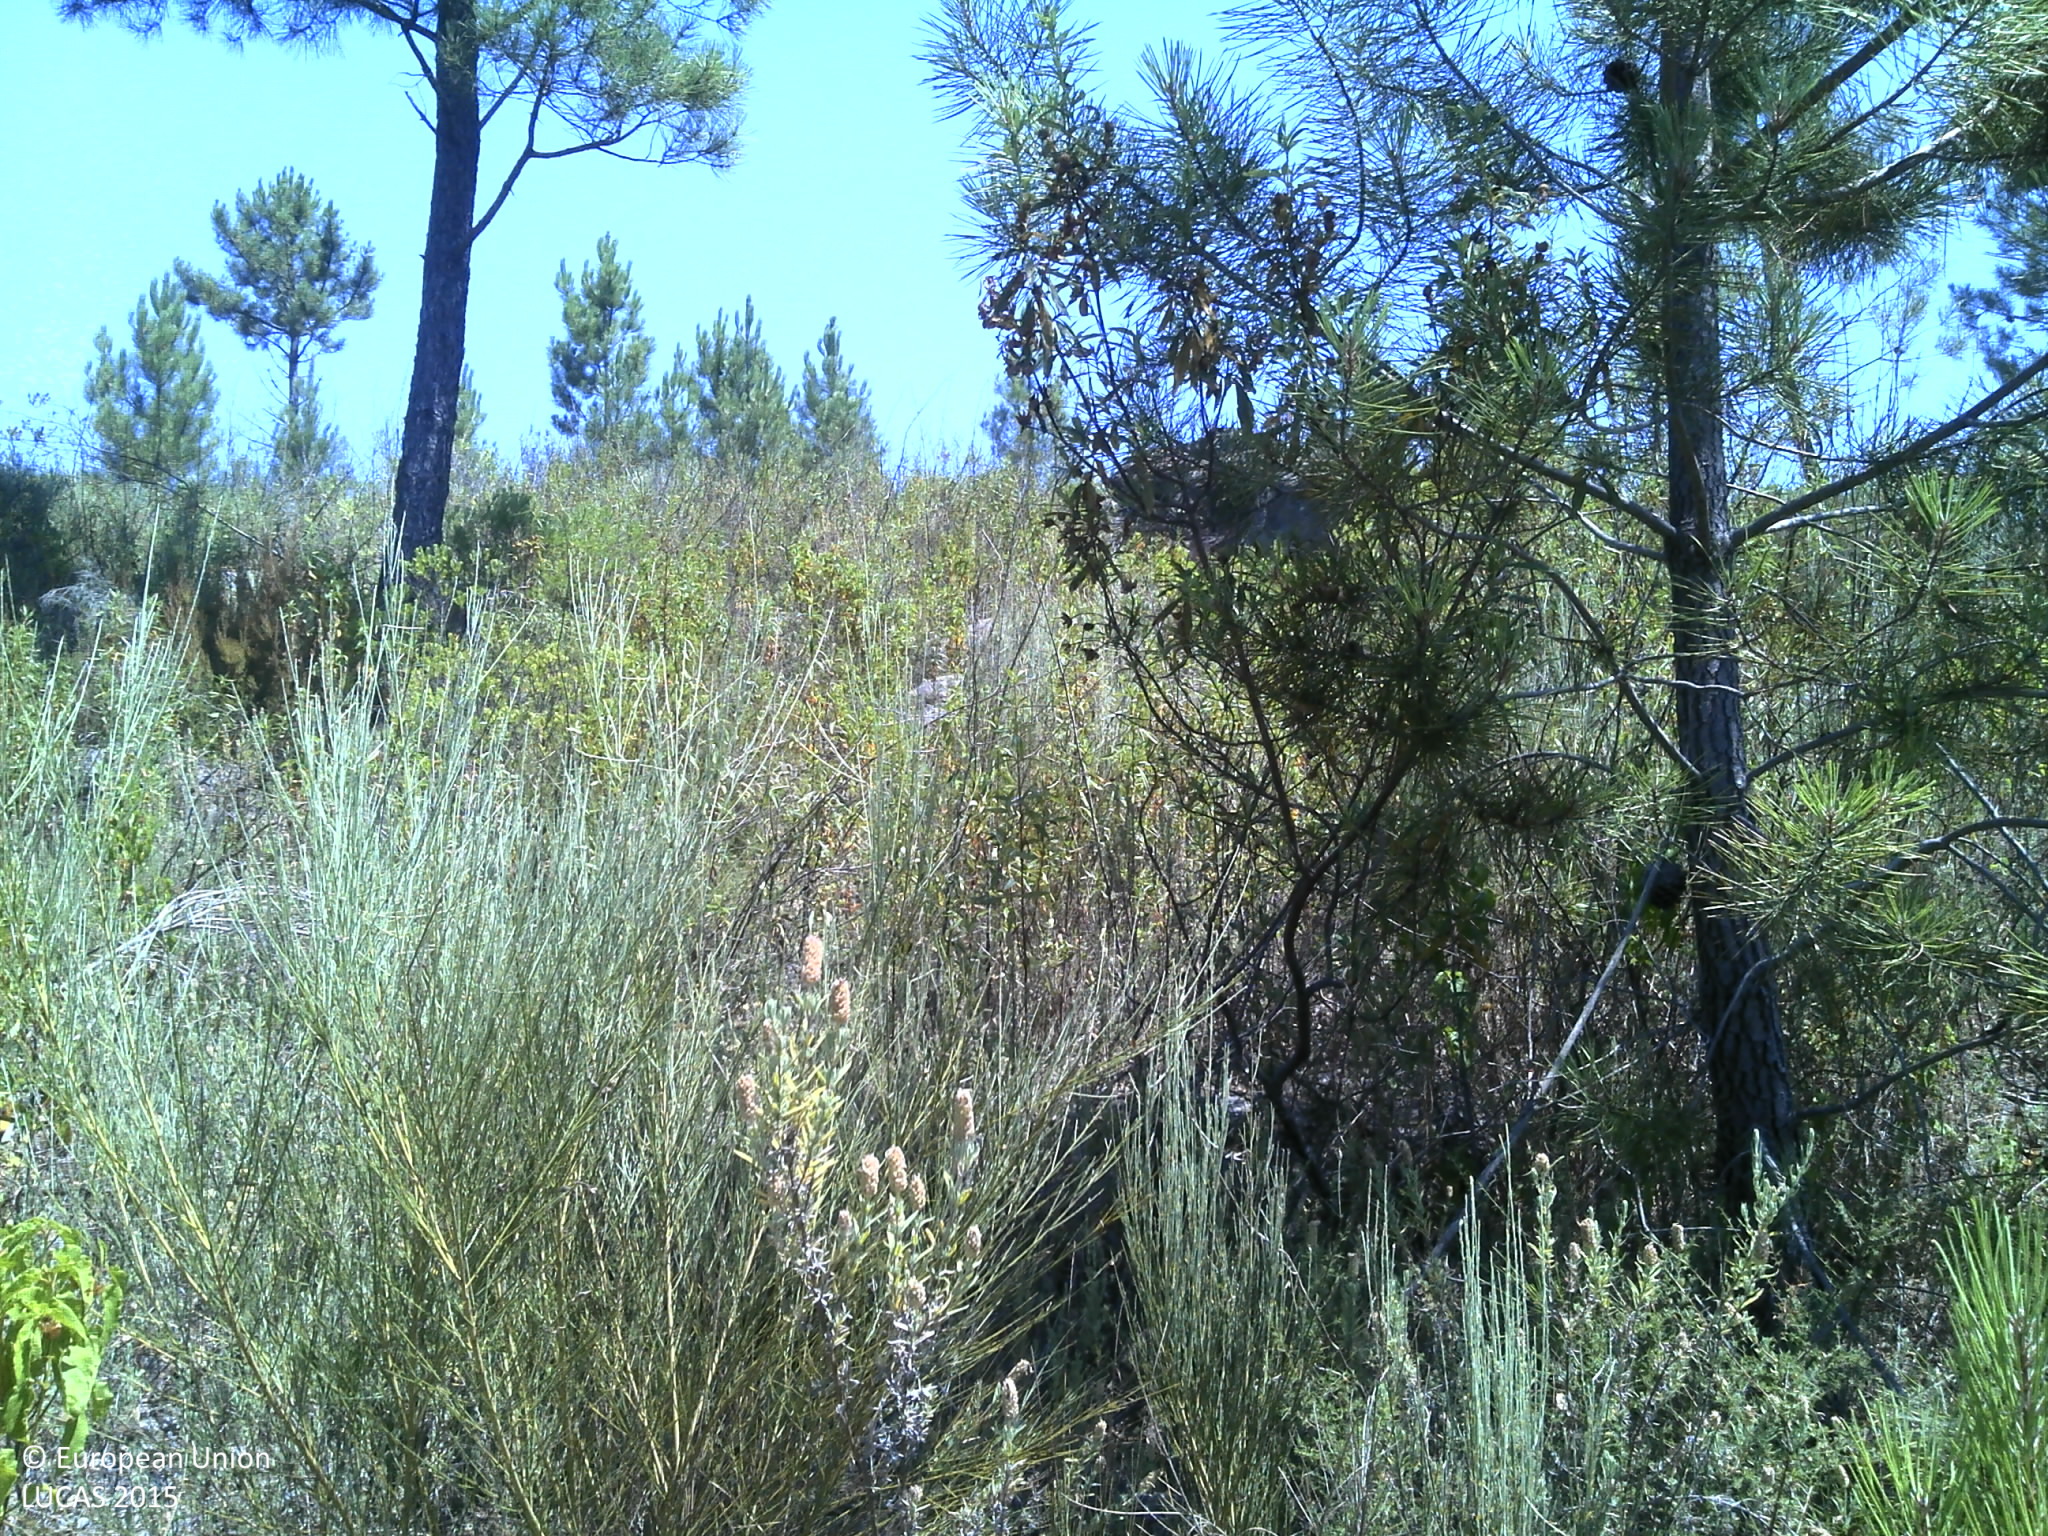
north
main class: Woodland
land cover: Pine dominated coniferous woodland
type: coniferous forest of the mediterranean region
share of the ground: 25 - 50 %
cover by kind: coniferous forest trees 30 %, shrubs 30 %, herbaceous plants 20 %, consolidated bare surface 10 %, unconsolidated bare surface 10 %
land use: Forestry
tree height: > 5 m
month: June
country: PT
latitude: 40.5112
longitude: -7.7857
